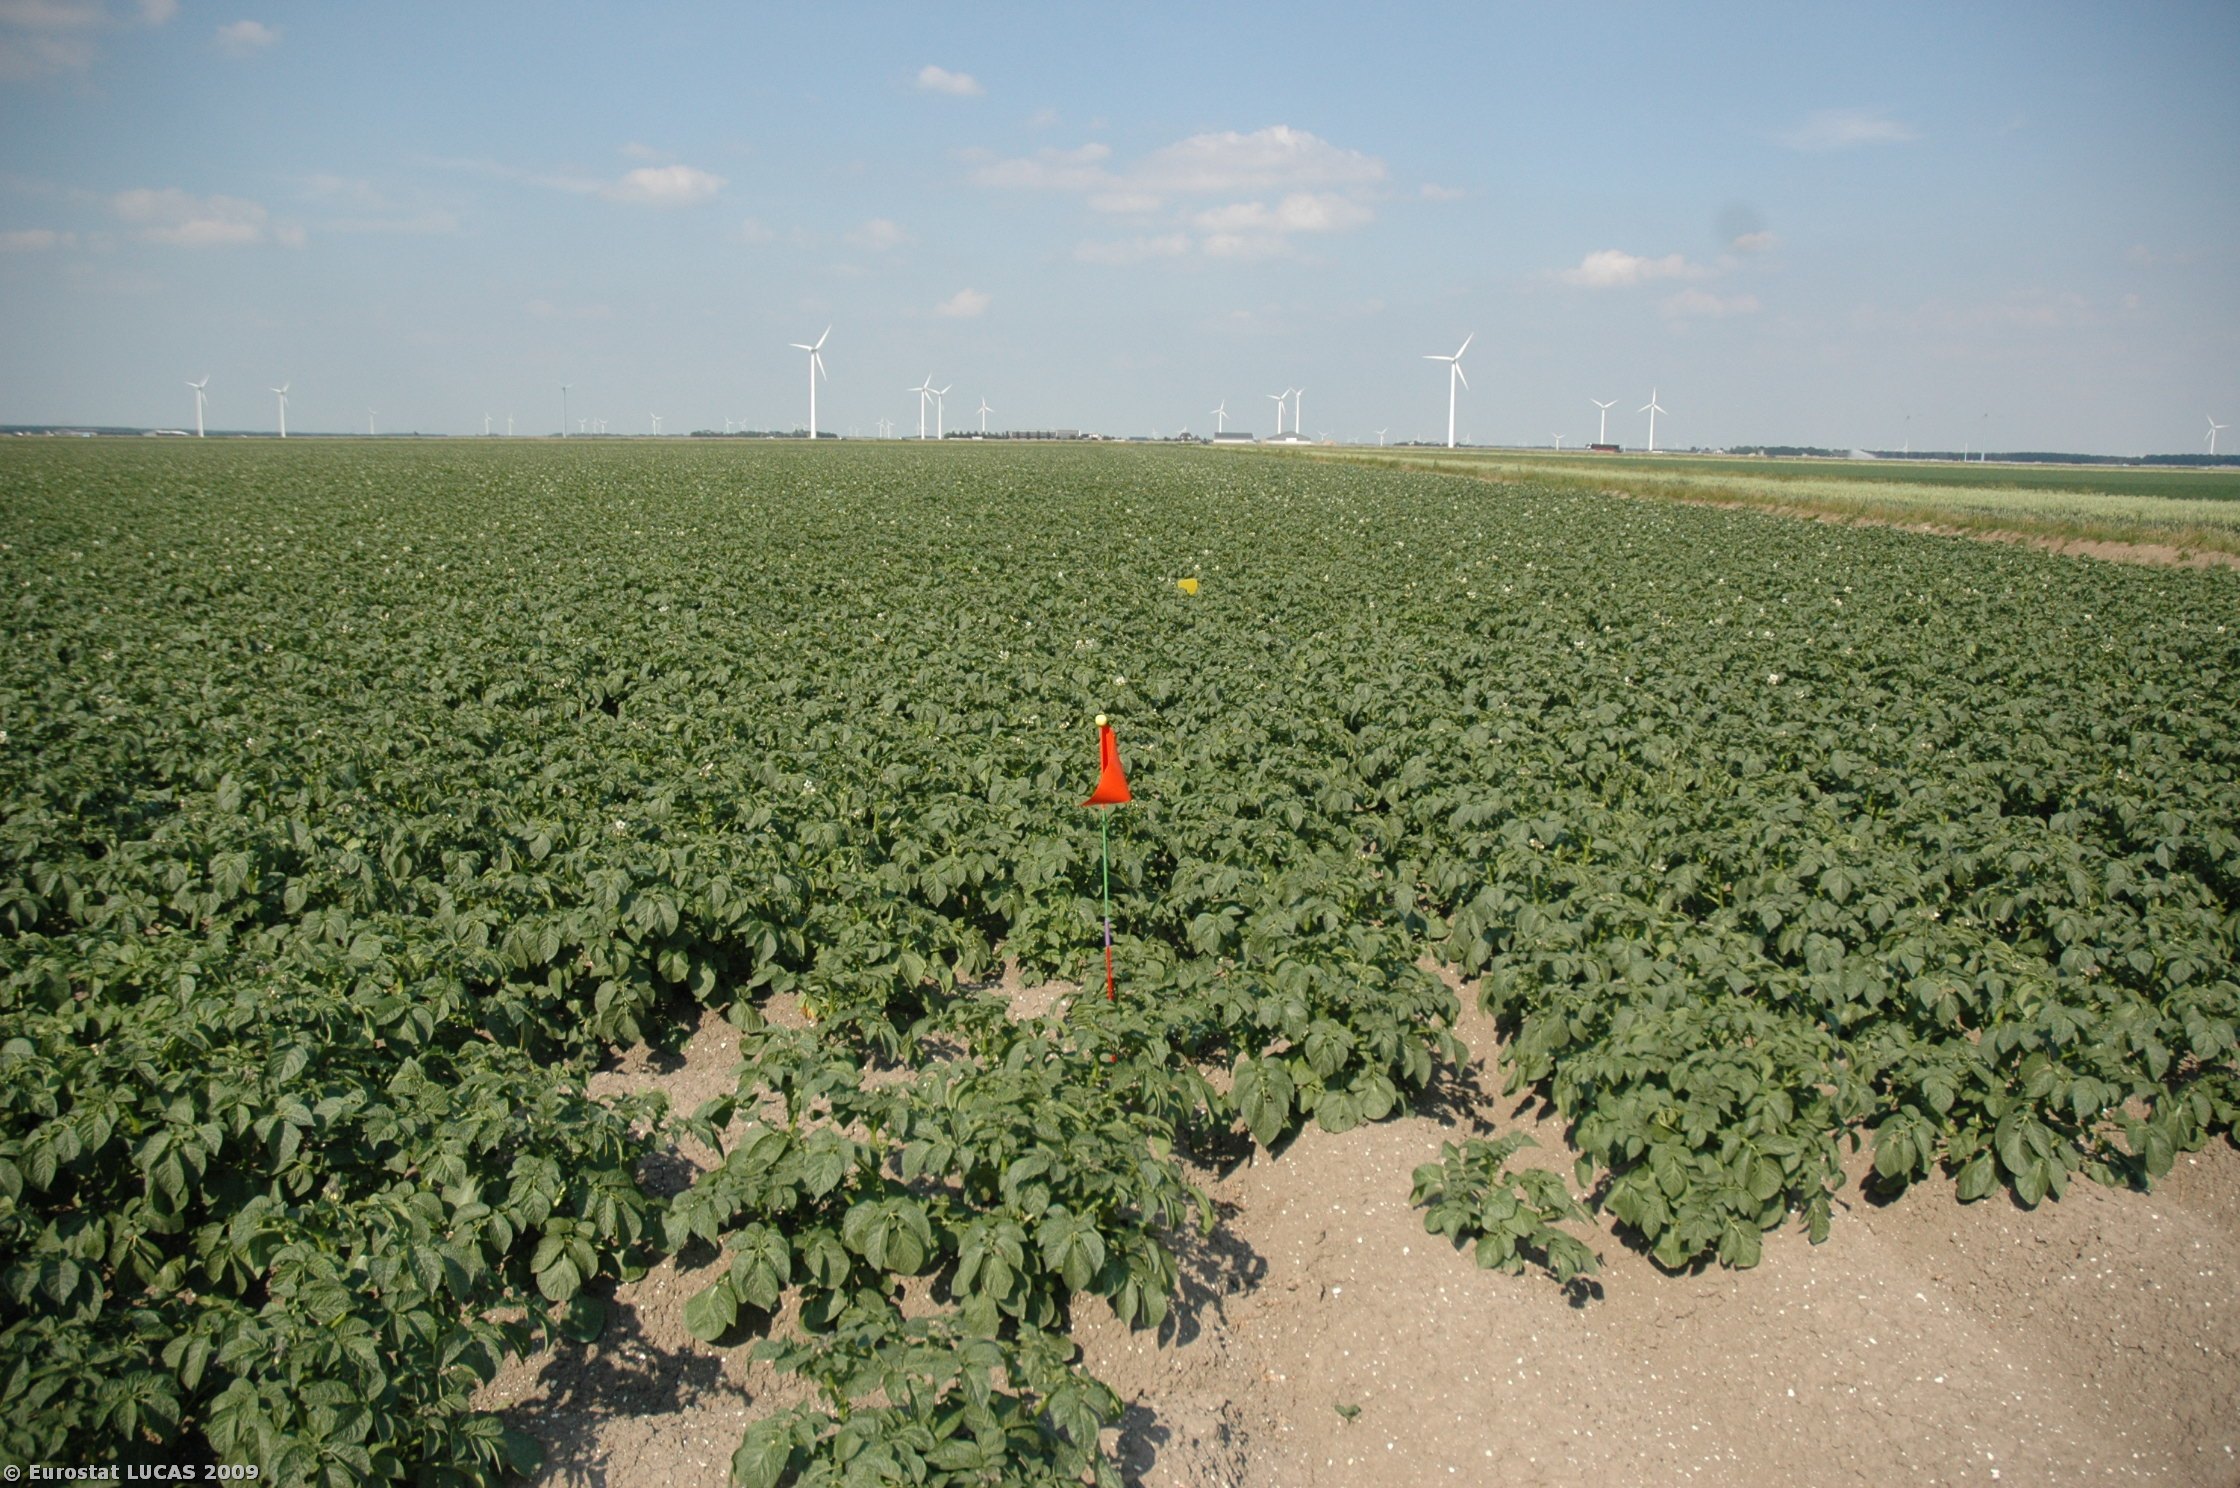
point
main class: Cropland
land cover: Potatoes
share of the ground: > 75 %
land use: Agriculture (excluding fallow land and kitchen gardens)
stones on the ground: < 10 %
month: June
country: NL
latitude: 52.3570
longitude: 5.3141
